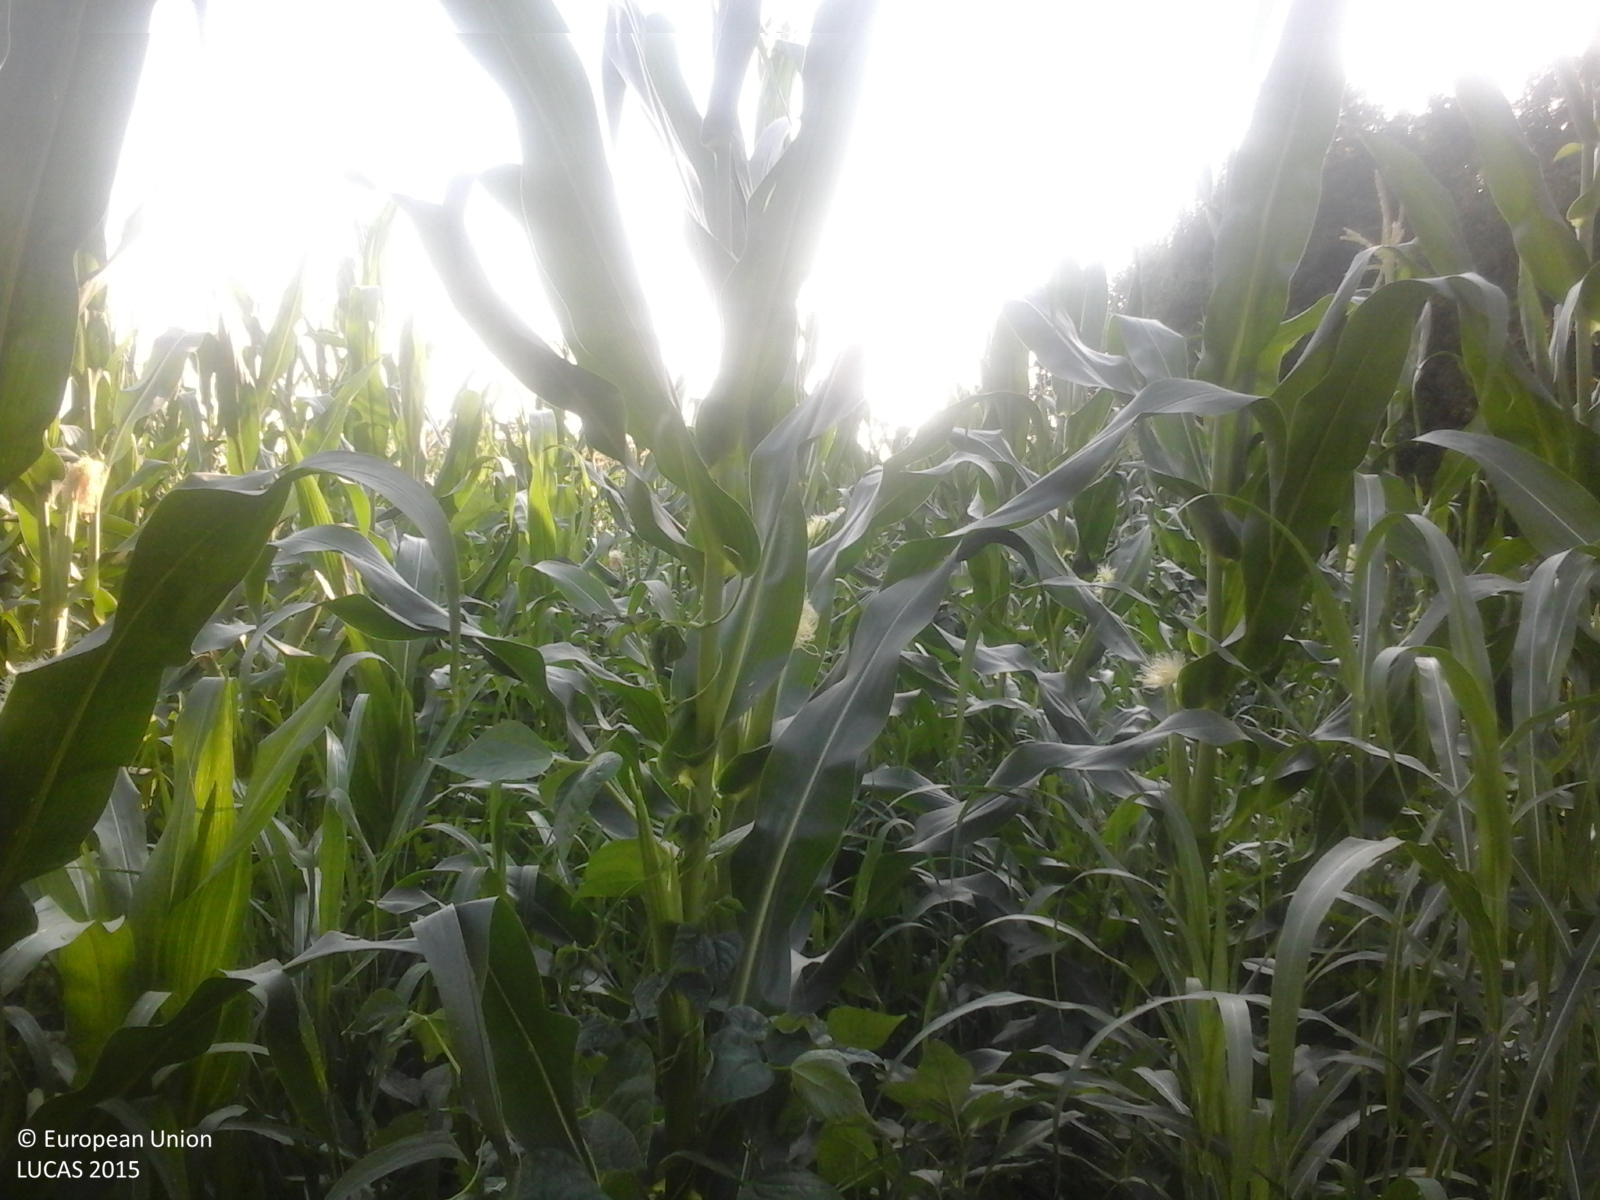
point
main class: Cropland
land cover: Maize
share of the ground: > 75 %
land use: Agriculture (excluding fallow land and kitchen gardens)
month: July
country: RO
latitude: 44.6073
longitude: 25.5028
